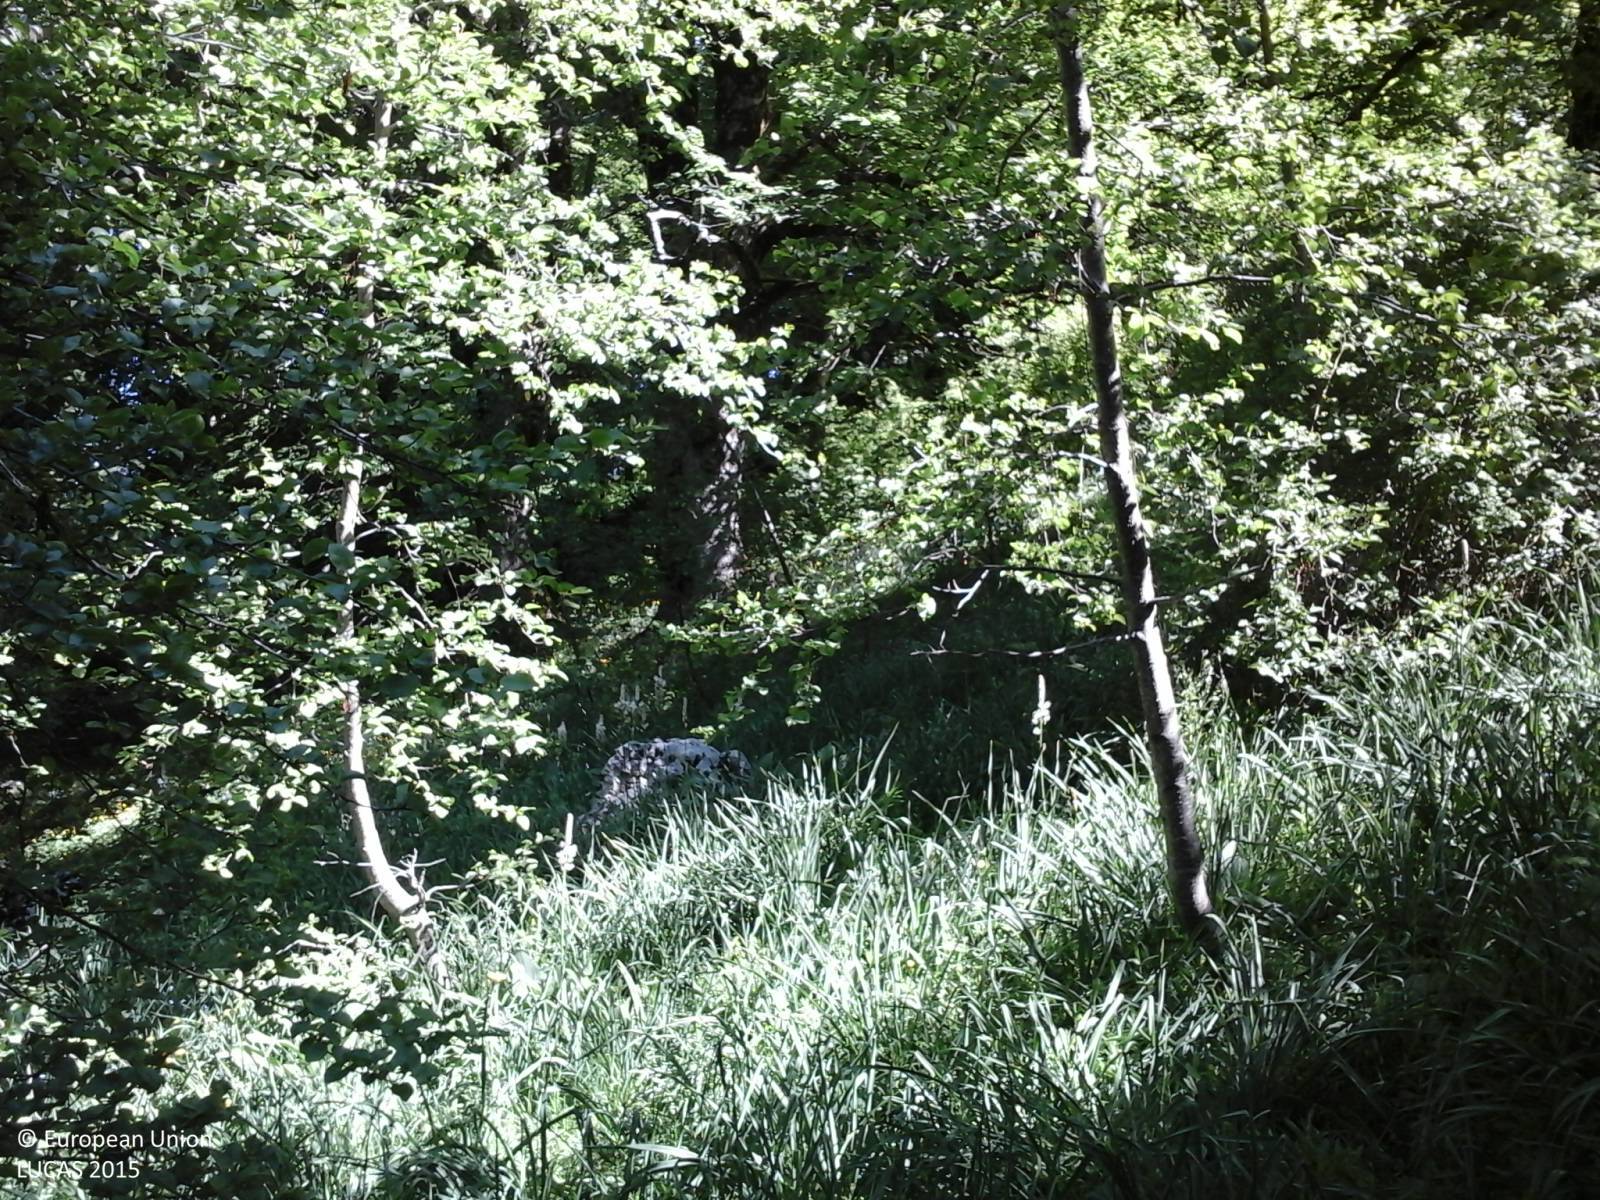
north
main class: Woodland
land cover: Broadleaved woodland
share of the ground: > 75 %
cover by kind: broadleaved forest trees 80 %, herbaceous plants 15 %, shrubs 5 %
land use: Semi-natural and natural areas not in use
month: May
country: IT
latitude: 42.0065
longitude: 13.2125
